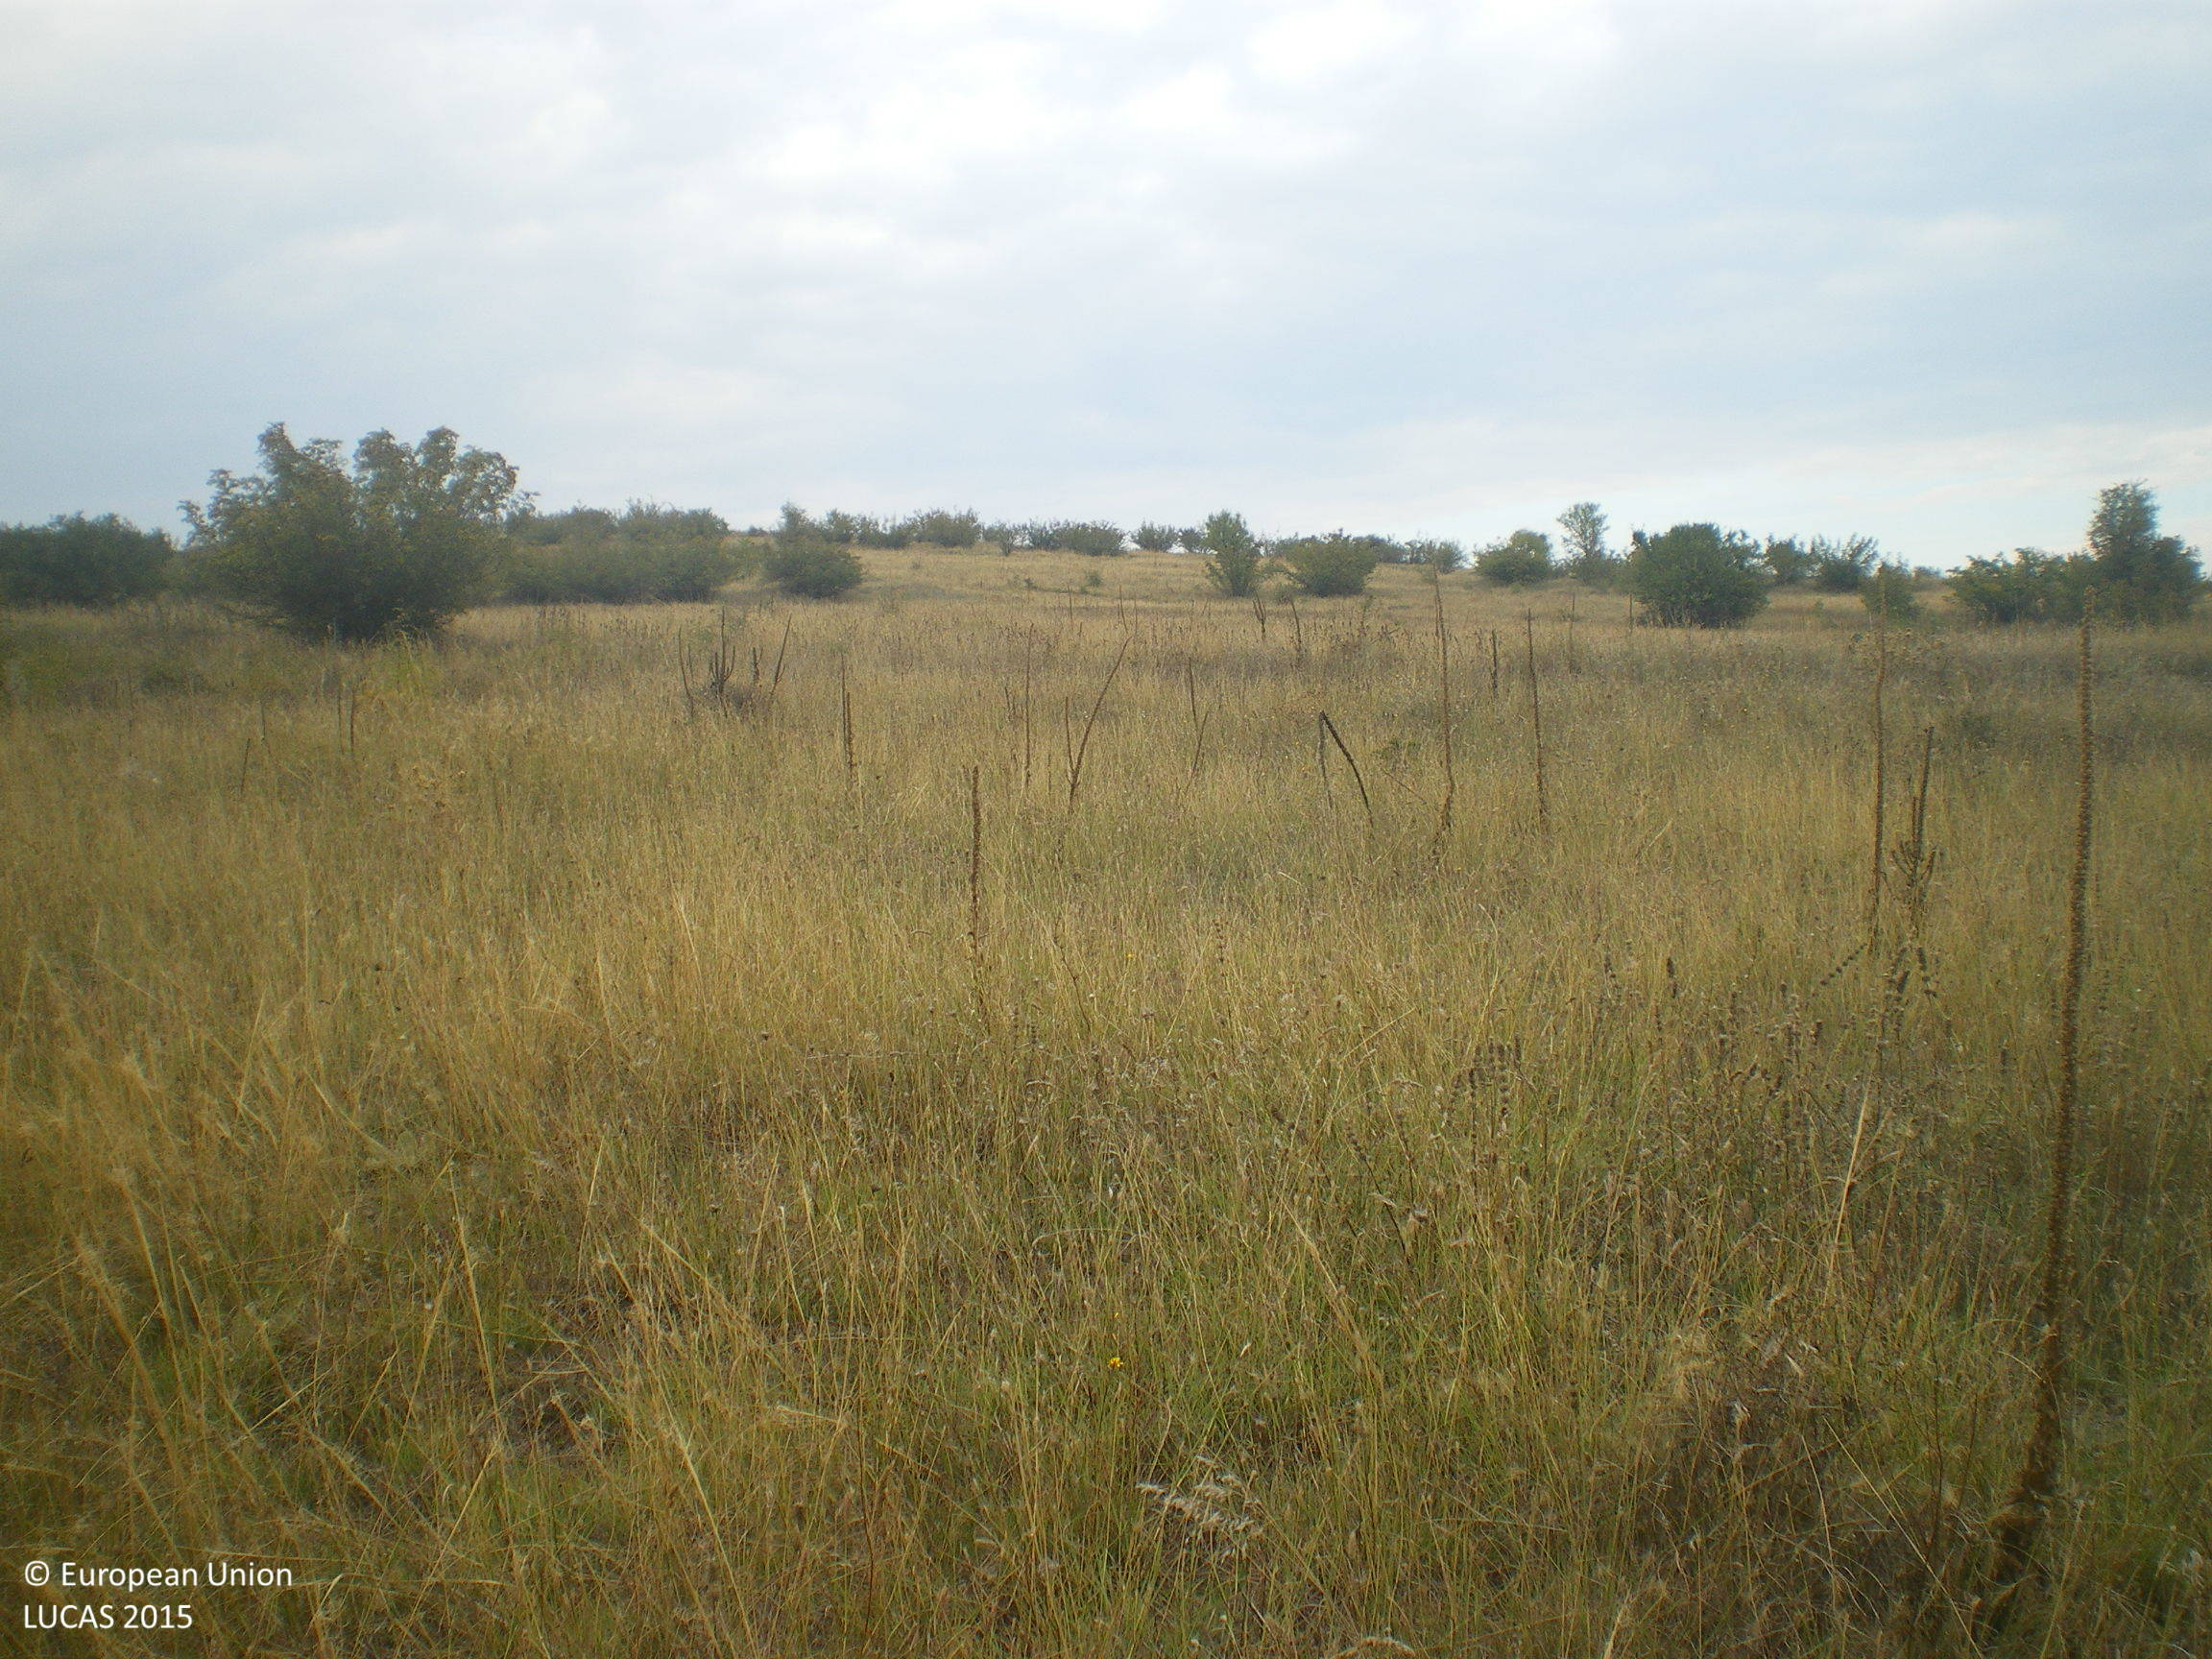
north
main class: Grassland
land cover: Grassland without tree/shrub cover
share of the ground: > 75 %
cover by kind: herbaceous plants 100 %
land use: Agriculture (excluding fallow land and kitchen gardens)
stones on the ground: 10 - 25 %
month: October
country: BG
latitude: 41.8811
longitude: 26.2623
